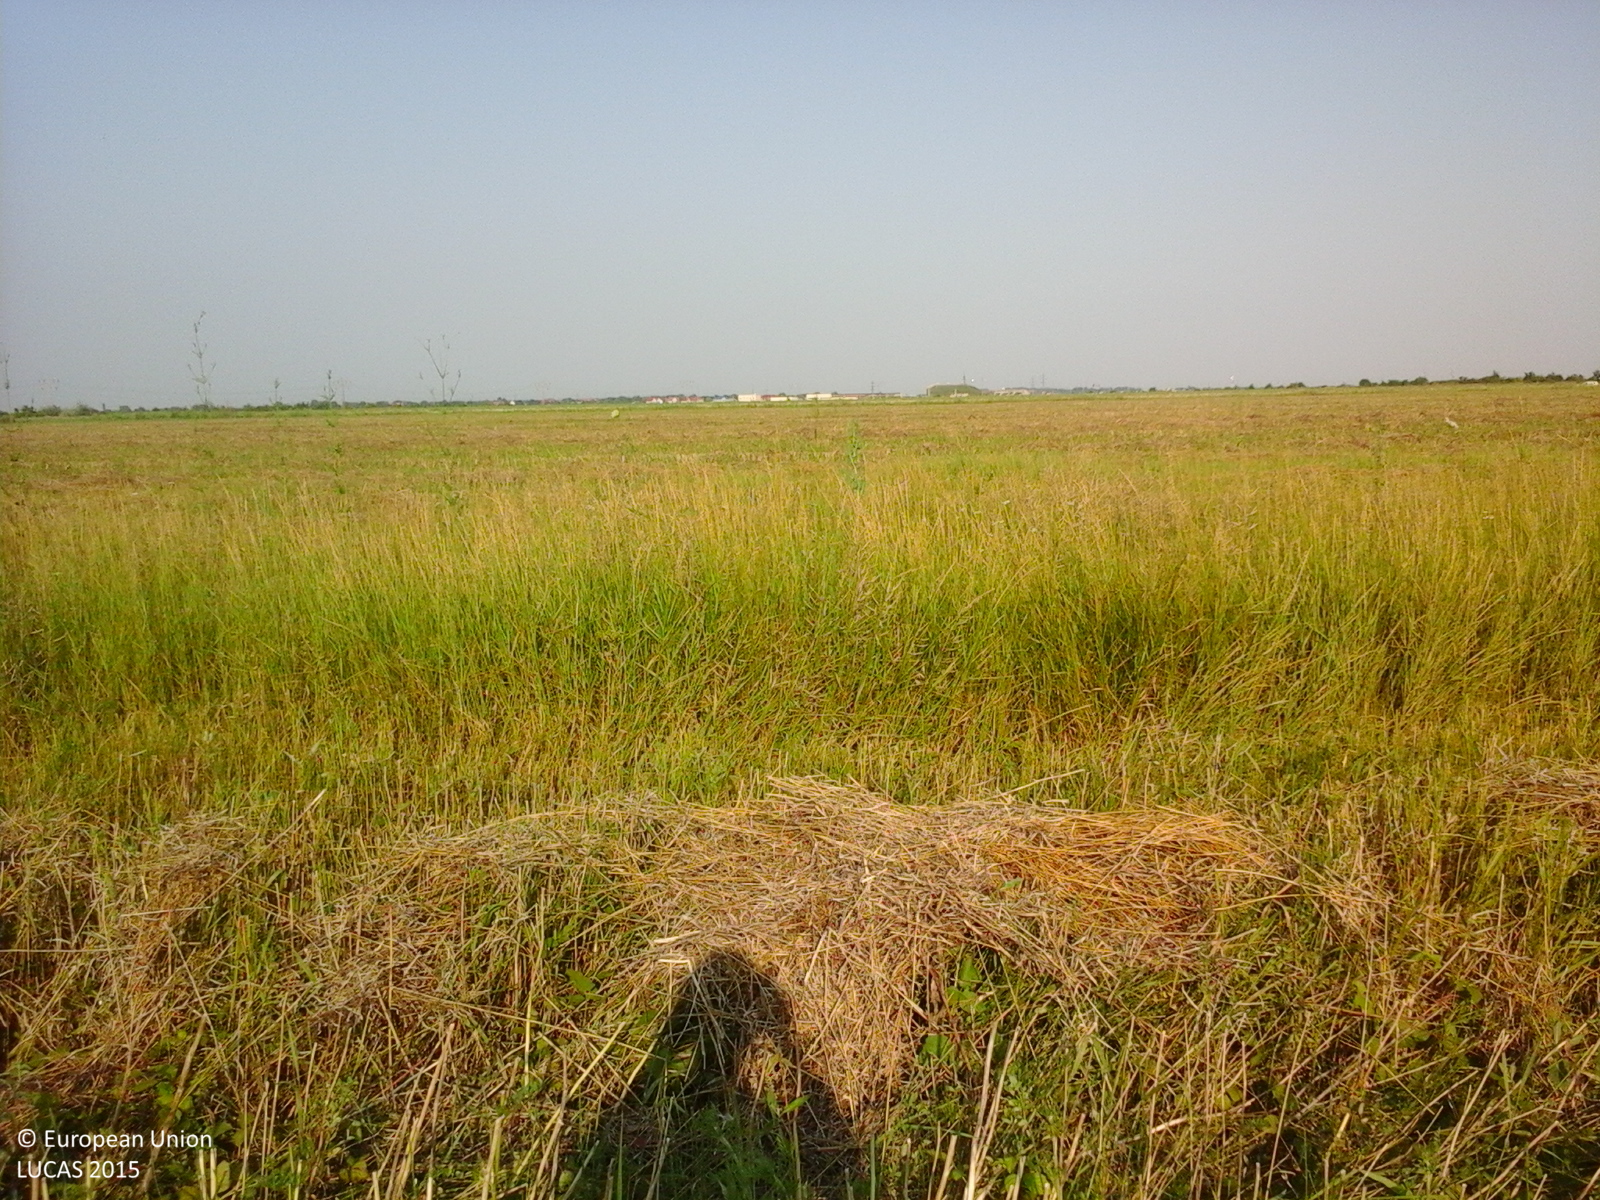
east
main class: Cropland
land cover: Rape and turnip rape
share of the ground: 50 - 75 %
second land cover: Spontaneously vegetated surfaces
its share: 25 - 50 %
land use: Agriculture (excluding fallow land and kitchen gardens)
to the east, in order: Rape and turnip rape; Spontaneously vegetated surfaces
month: July
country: RO
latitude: 44.6552
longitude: 25.6711
